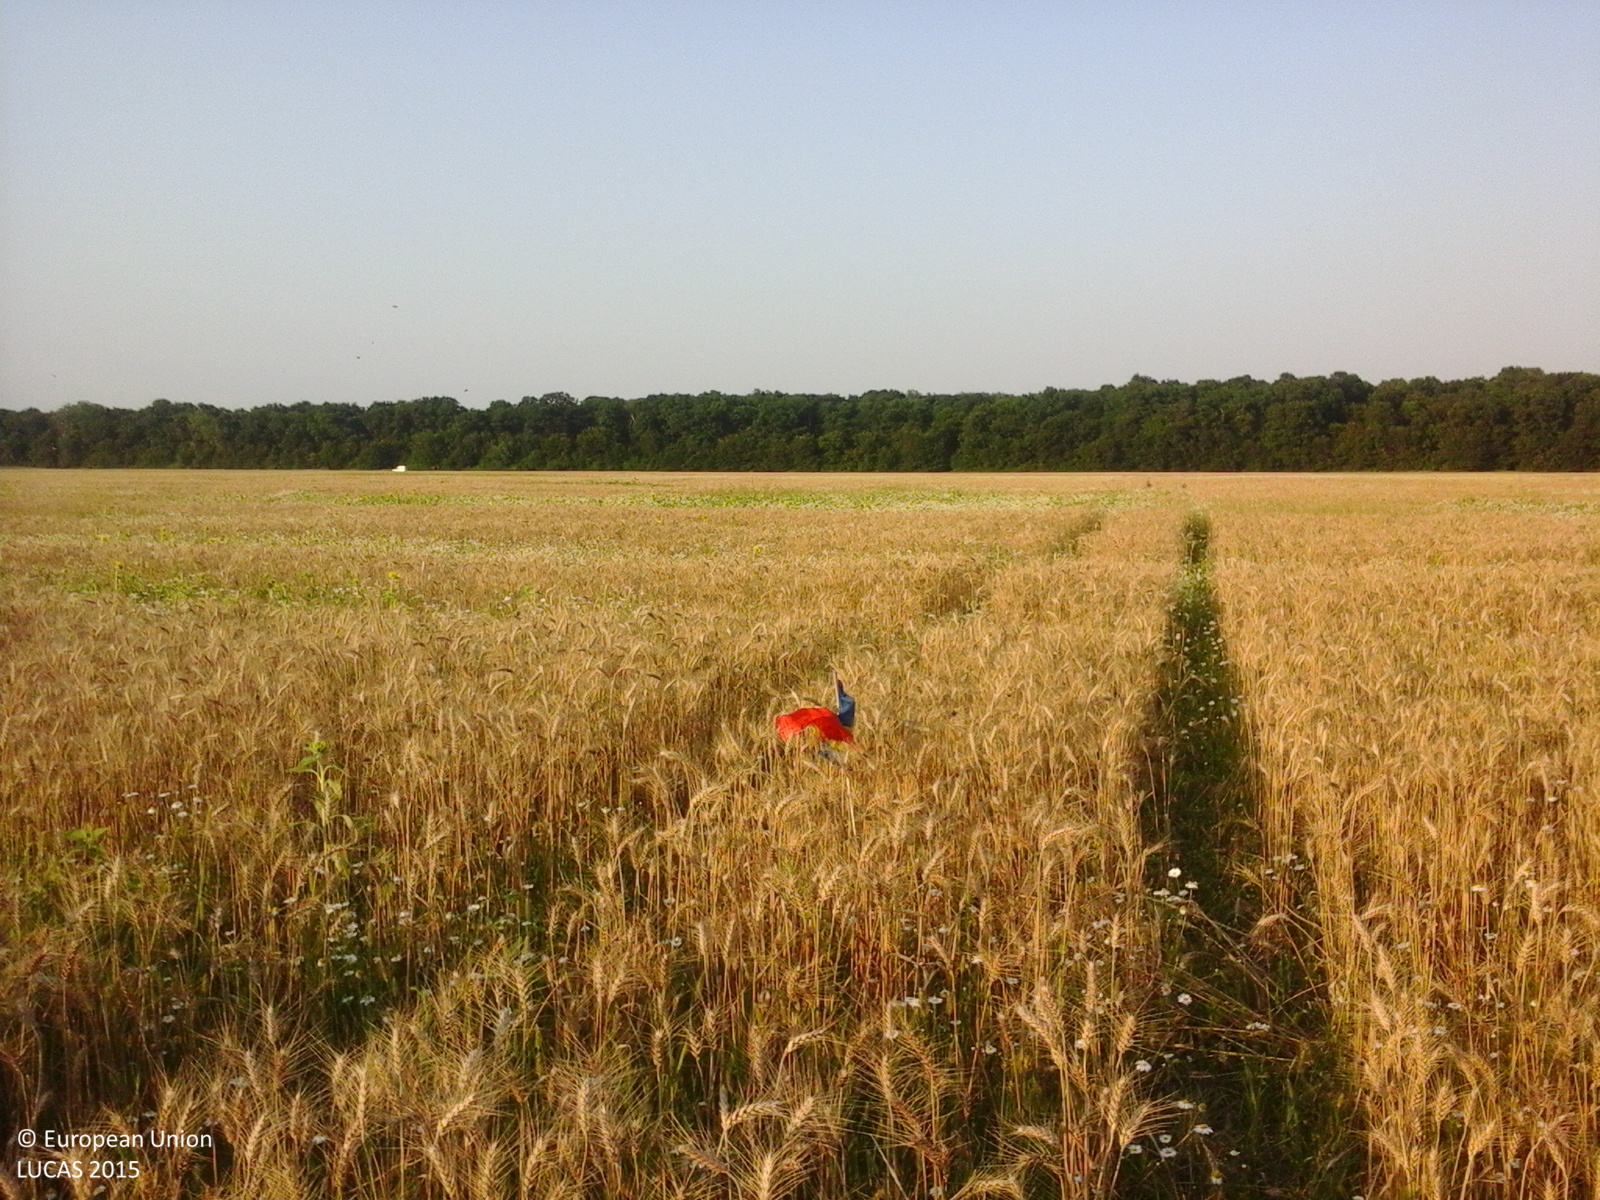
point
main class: Cropland
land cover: Common wheat
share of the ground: > 75 %
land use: Agriculture (excluding fallow land and kitchen gardens)
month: July
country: RO
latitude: 44.7080
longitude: 25.6861
